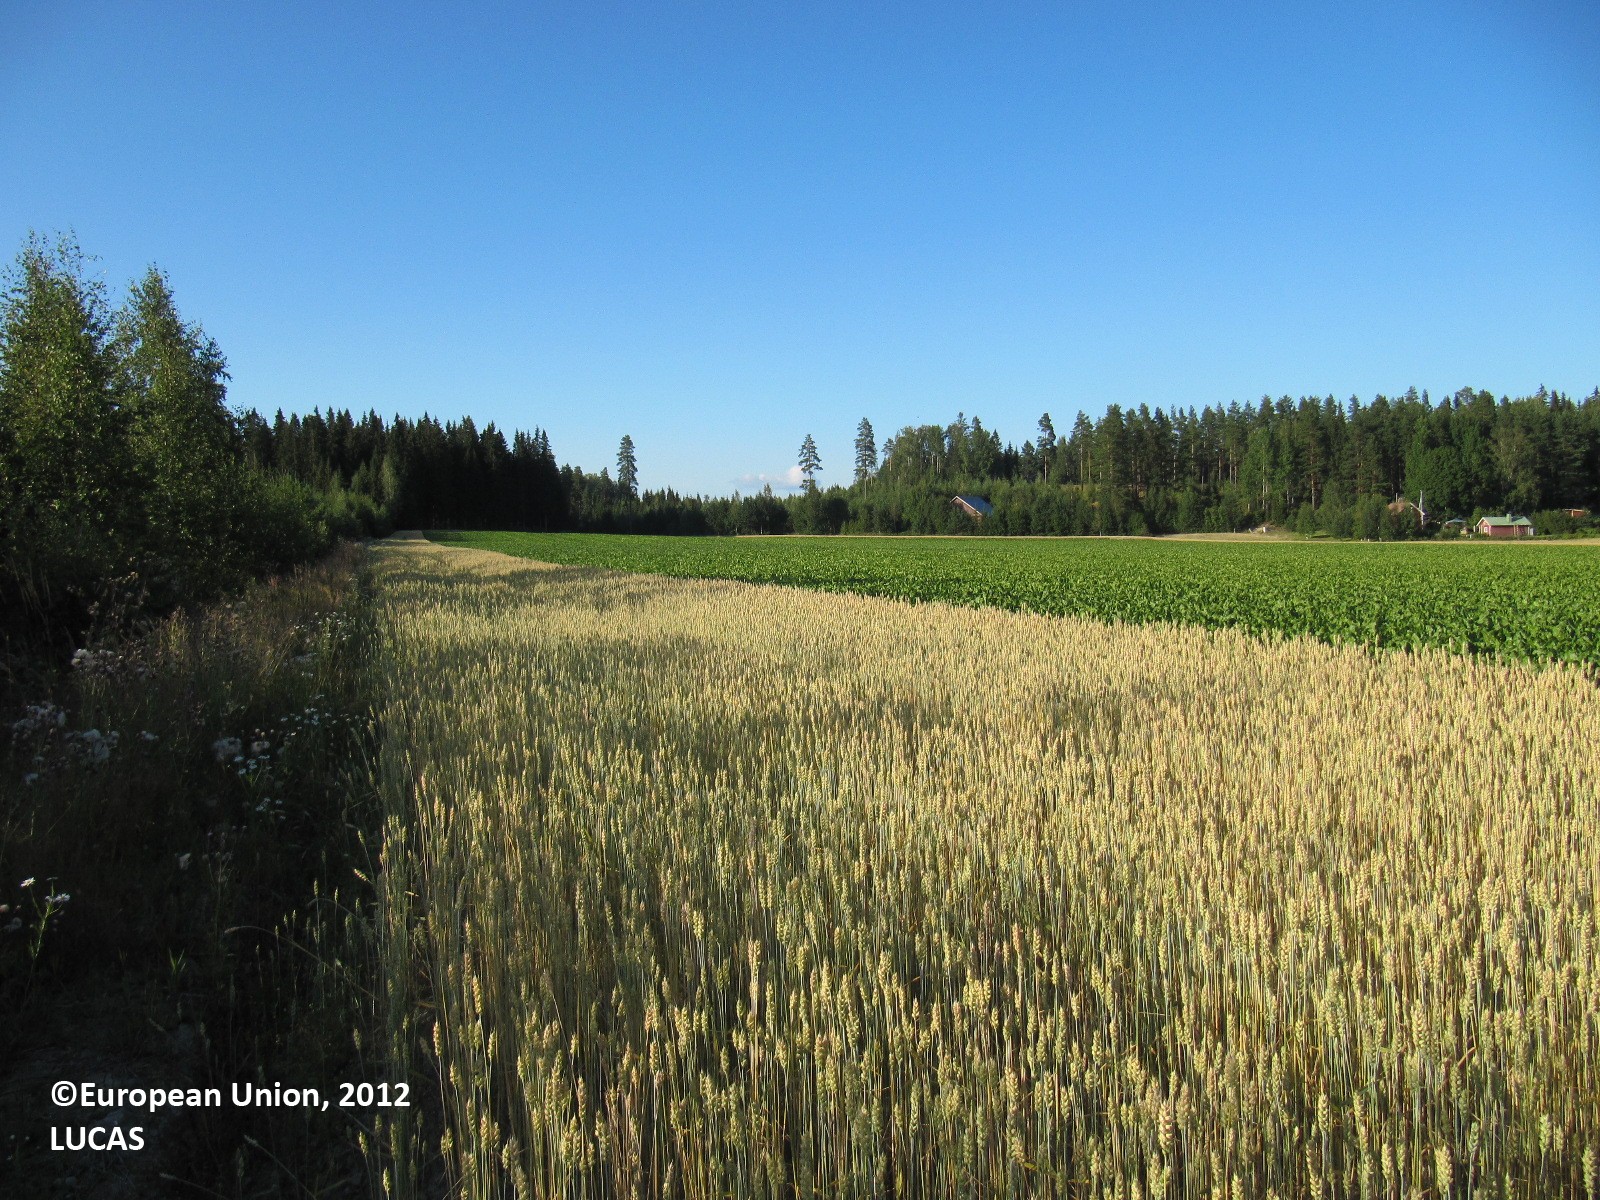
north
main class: Cropland
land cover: Common wheat
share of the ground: > 75 %
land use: Agriculture (excluding fallow land and kitchen gardens)
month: August
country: FI
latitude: 60.6729
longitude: 24.5097
